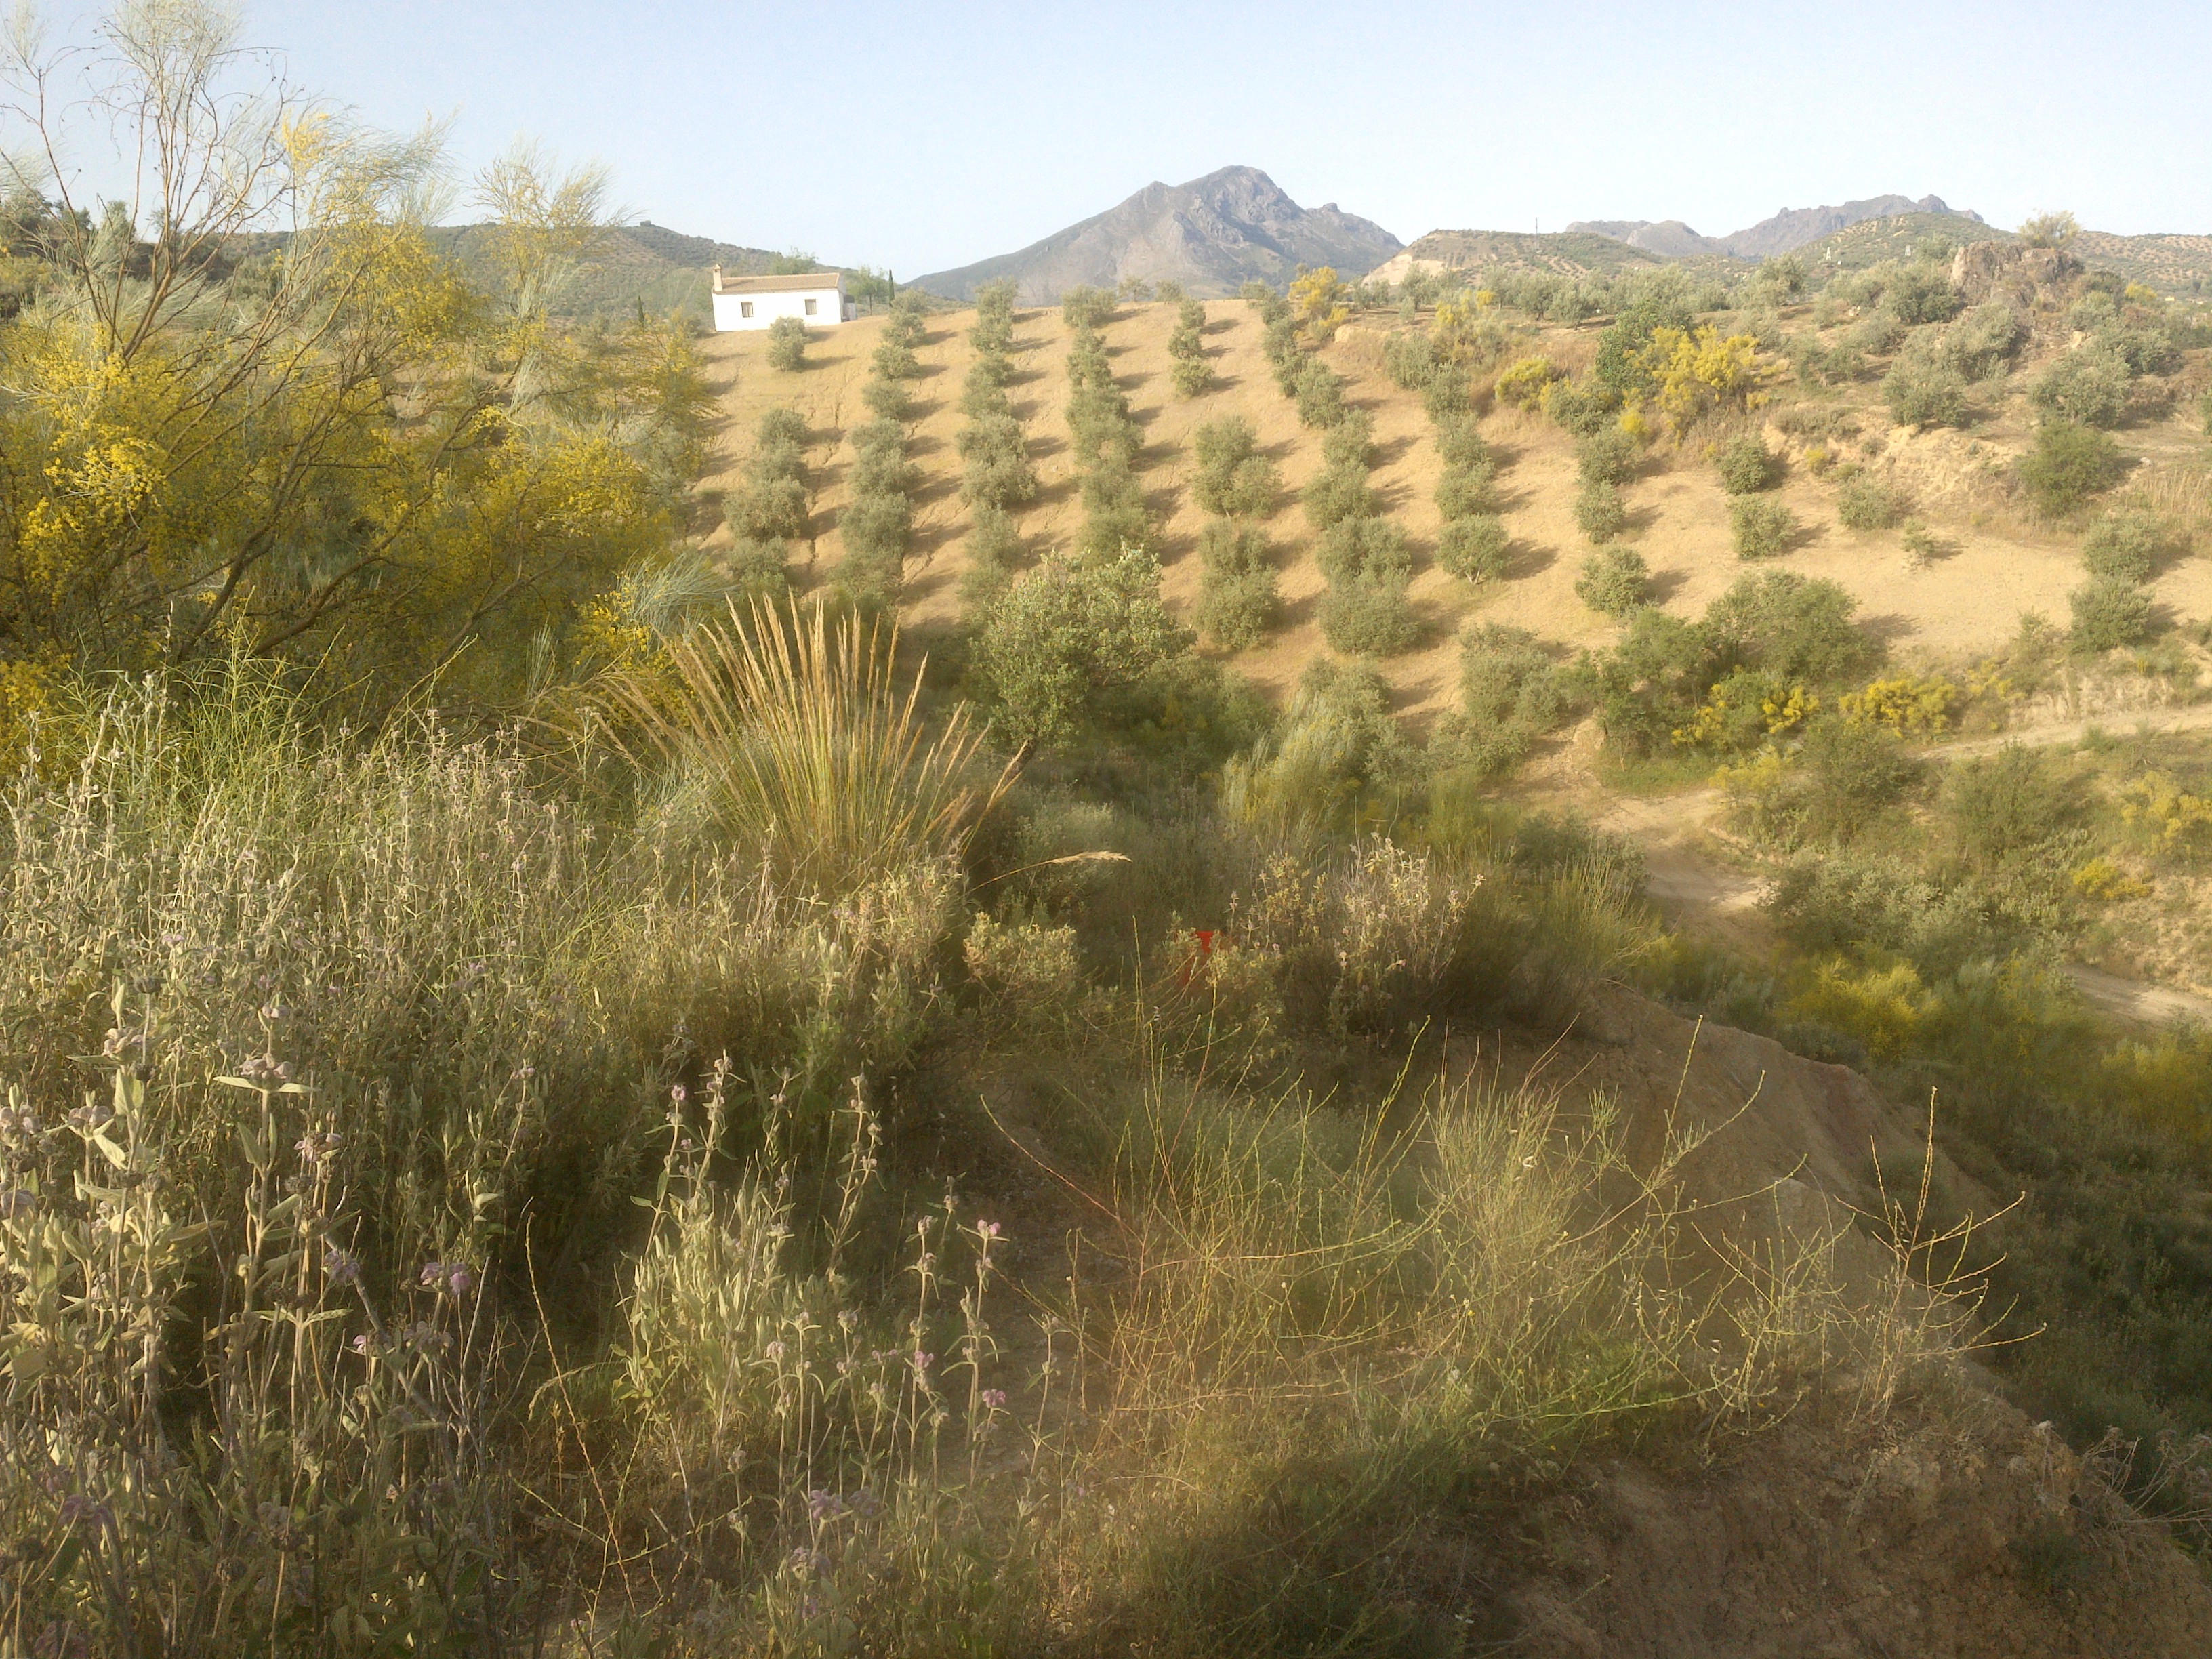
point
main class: Shrubland
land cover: Shrubland with sparse tree cover
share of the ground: 25 - 50 %
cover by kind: unconsolidated bare surface 35 %, shrubs 30 %, herbaceous plants 30 %, broadleaved forest trees 5 %
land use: Abandoned areas
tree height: < 5 m
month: May
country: ES
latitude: 37.4500
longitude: -4.1863
